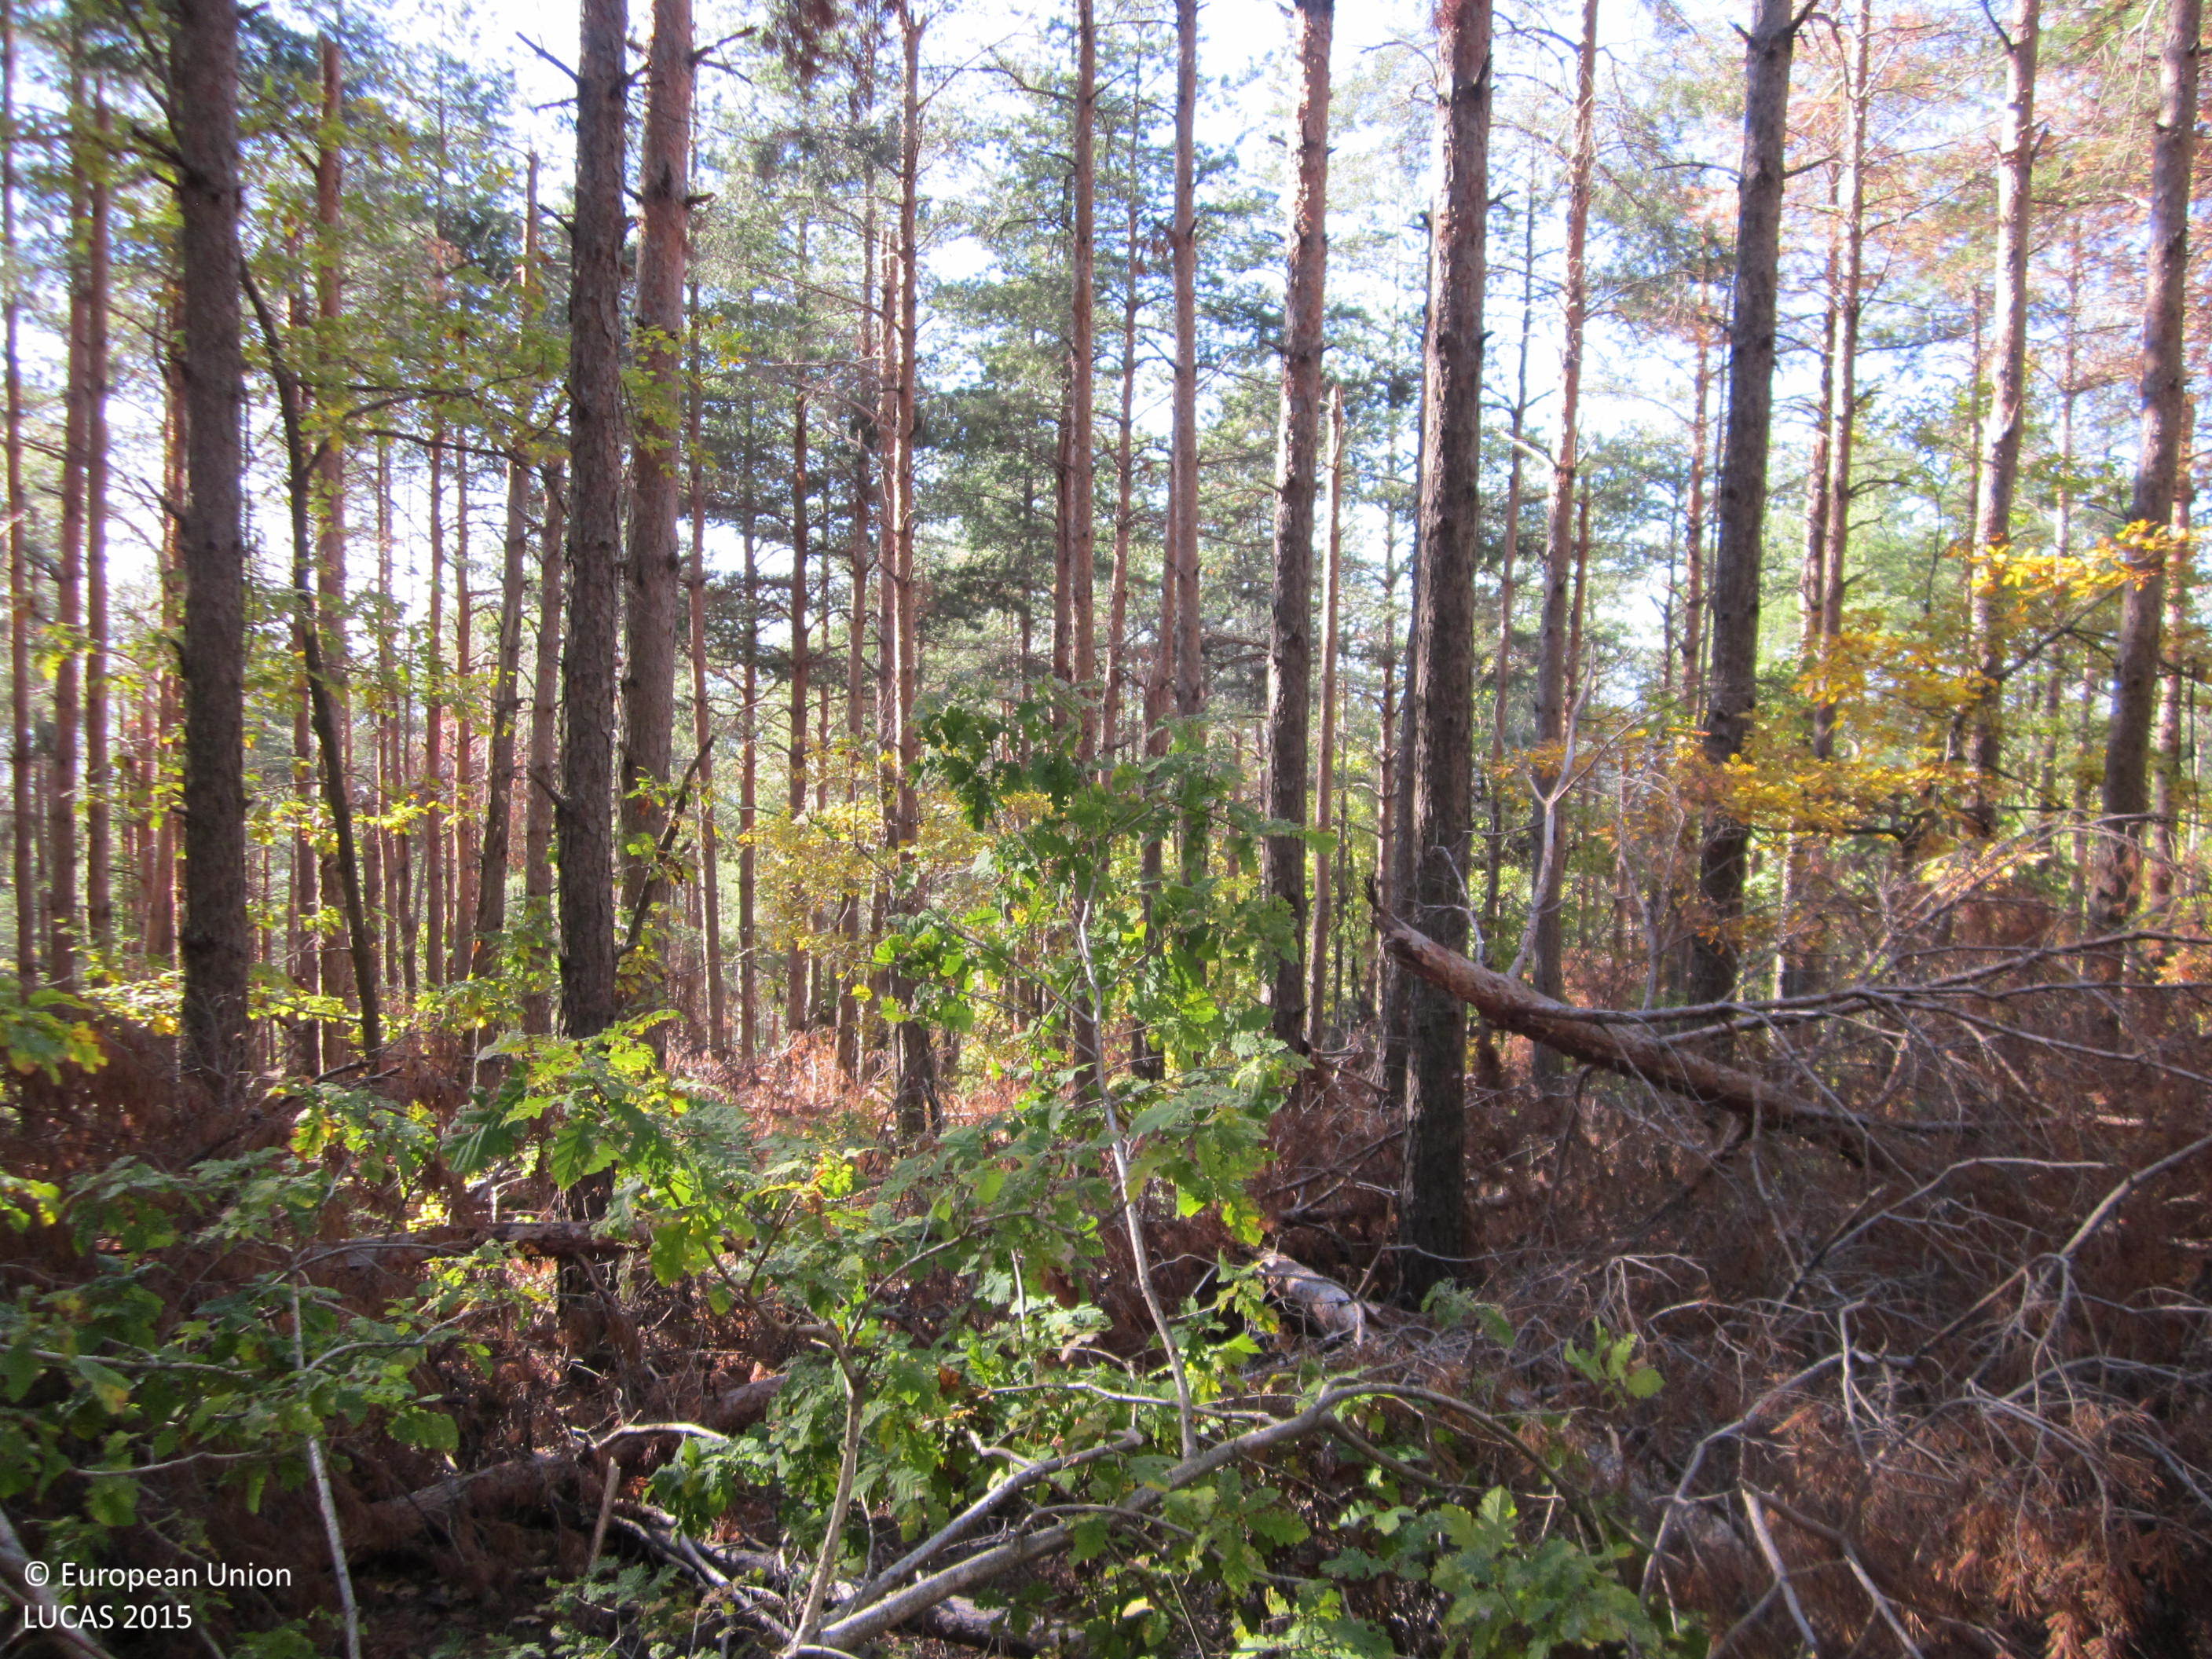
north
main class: Woodland
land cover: Pine dominated coniferous woodland
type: hemiboreal forest and nemoral coniferous forest and mixed broadleaved-coniferous forest
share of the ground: > 75 %
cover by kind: coniferous forest trees 70 %, unconsolidated bare surface 15 %, broadleaved forest trees 10 %, shrubs 5 %
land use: Forestry
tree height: > 5 m
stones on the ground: < 10 %
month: November
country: BG
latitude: 41.3921
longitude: 25.7644
